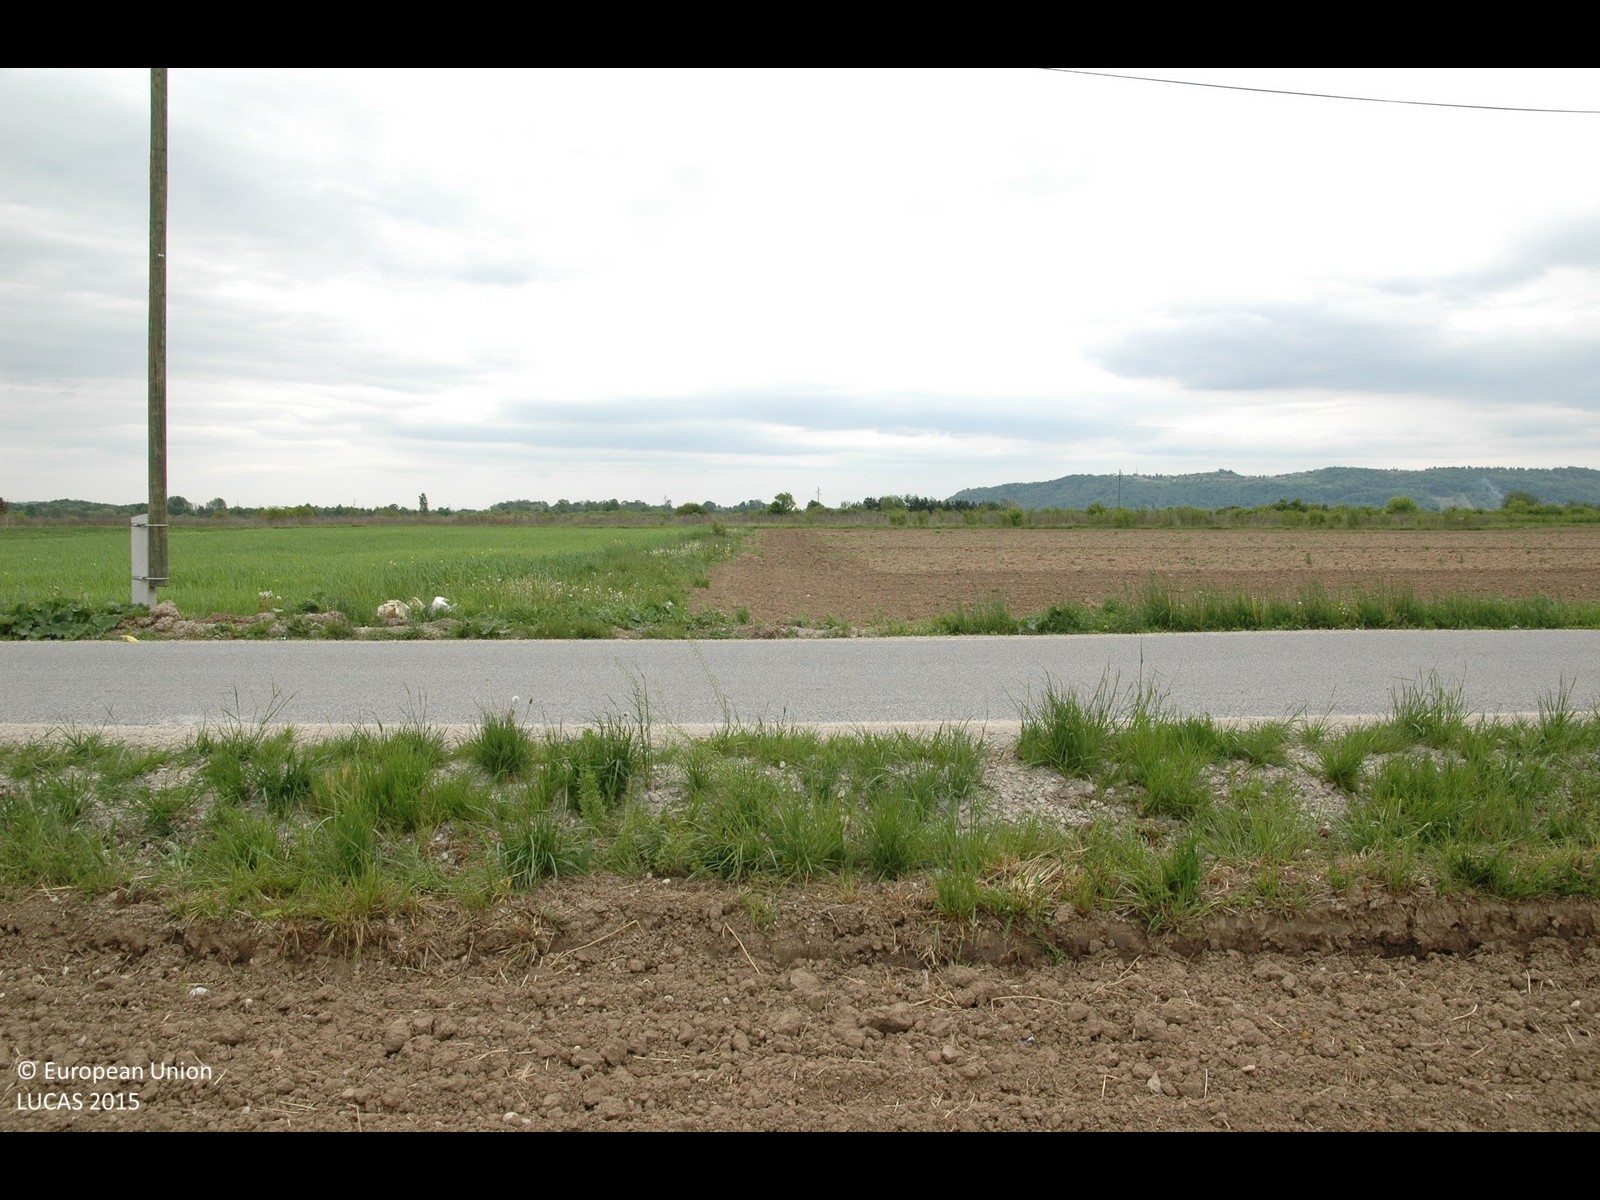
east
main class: Cropland
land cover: Maize
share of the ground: < 10 %
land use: Agriculture (excluding fallow land and kitchen gardens)
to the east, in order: Maize; Grass margins; Paved roads, cycling and walking lanes; Grass margins; Electric lines; Common wheat; Maize; Spontaneously vegetated surfaces; Maize; Tracks; Spontaneously vegetated surfaces; Maize
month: May
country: HR
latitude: 45.8187
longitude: 15.7248
